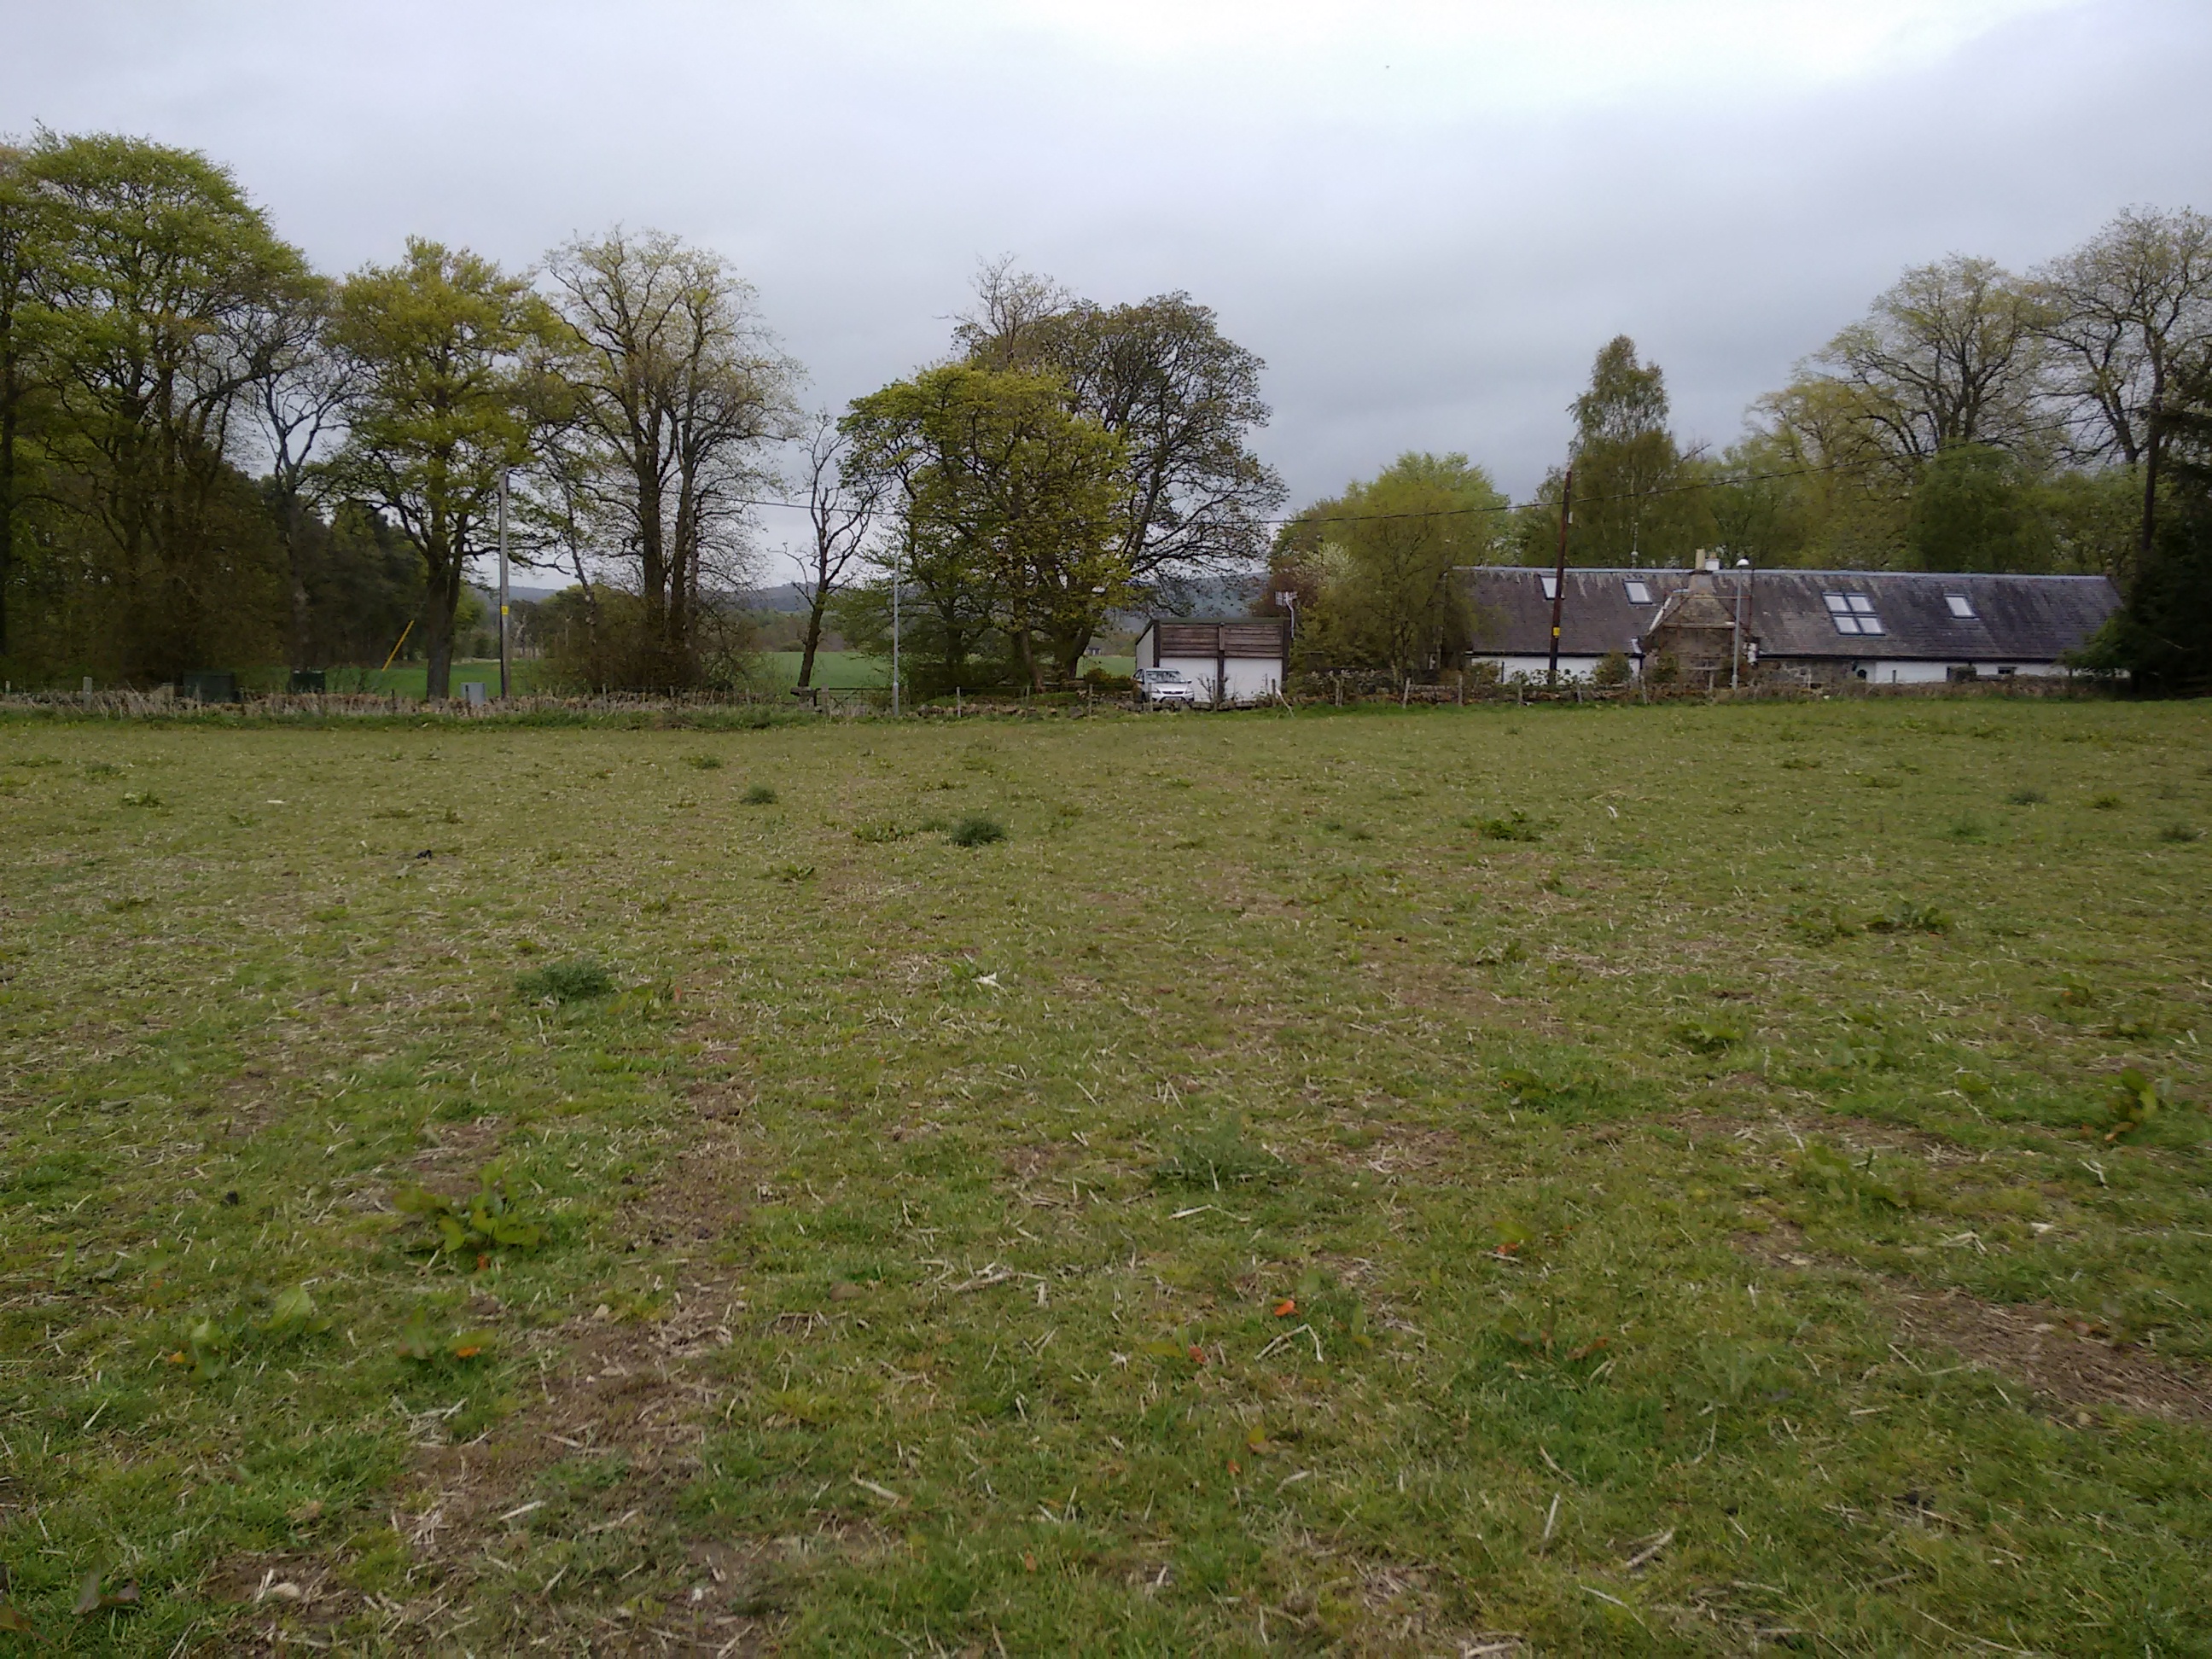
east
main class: Grassland
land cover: Grassland without tree/shrub cover
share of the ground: > 75 %
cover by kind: herbaceous plants 95 %, unconsolidated bare surface 5 %
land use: Agriculture (excluding fallow land and kitchen gardens)
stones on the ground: < 10 %
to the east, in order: Grassland without tree/shrub cover; Fences; Dry stone walls; Paved roads, cycling and walking lanes; Grass margins; Artificial constructions in urban areas; Grass margins; Common wheat; Grass margins; Artificial constructions in urban areas; Grassland without tree/shrub cover
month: May
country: GB
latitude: 55.9232
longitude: -3.6999
